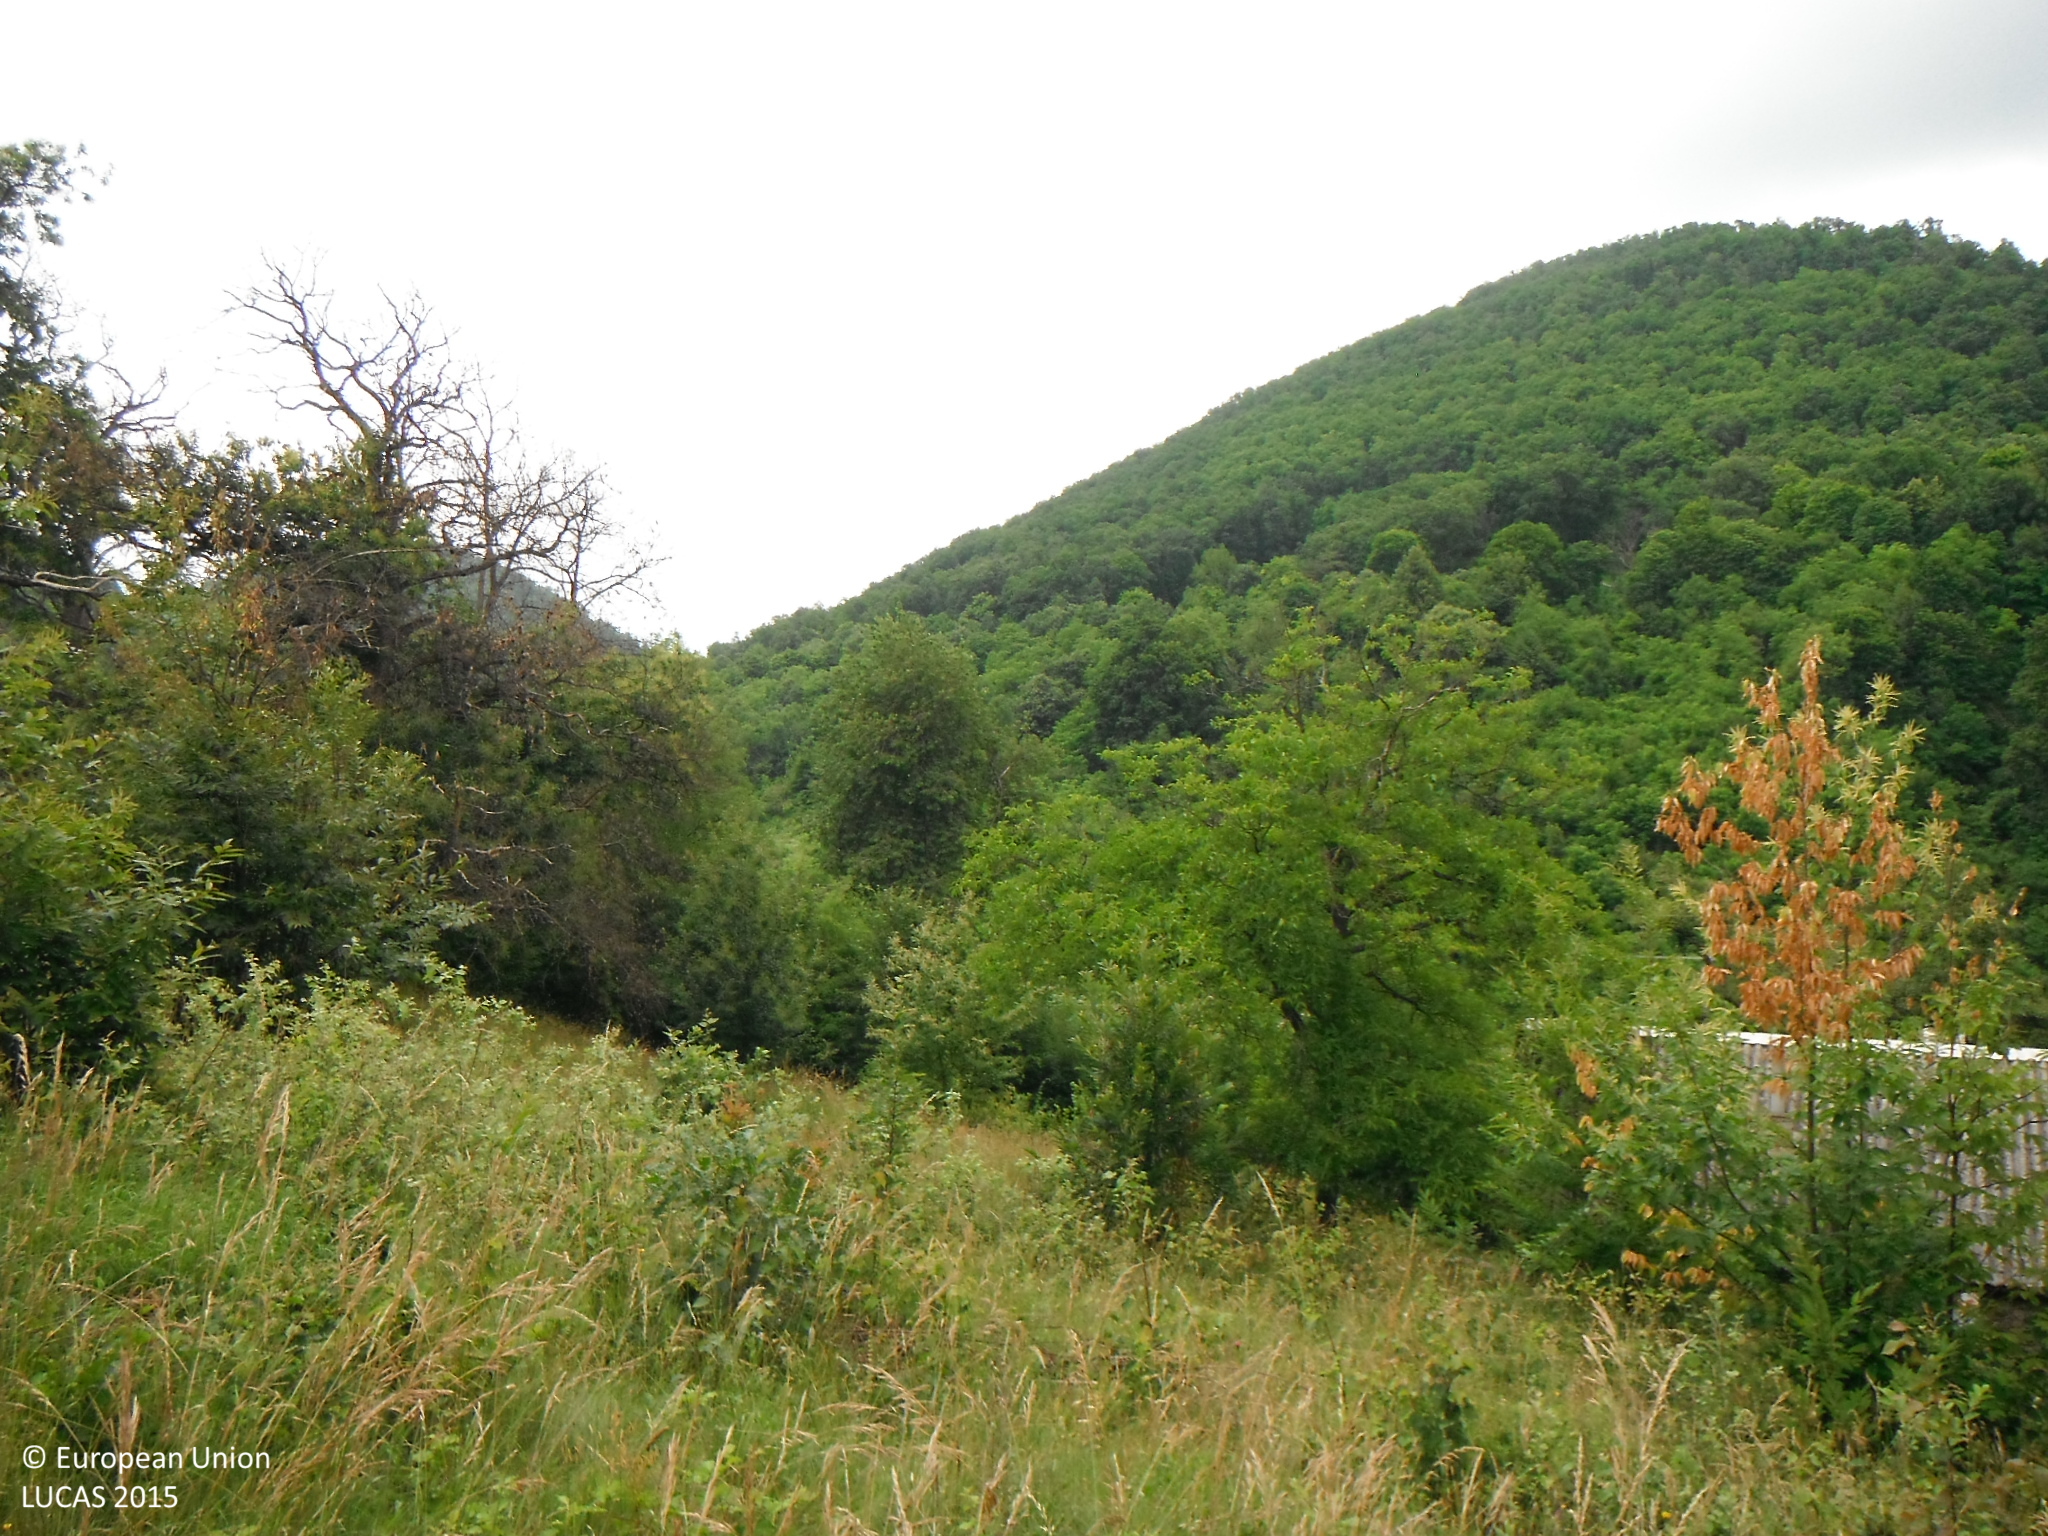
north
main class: Grassland
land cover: Grassland with sparse tree/shrub cover
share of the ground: > 75 %
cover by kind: herbaceous plants 85 %, shrubs 10 %, broadleaved forest trees 5 %
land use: Semi-natural and natural areas not in use
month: June
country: SK
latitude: 48.2439
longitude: 19.3276
